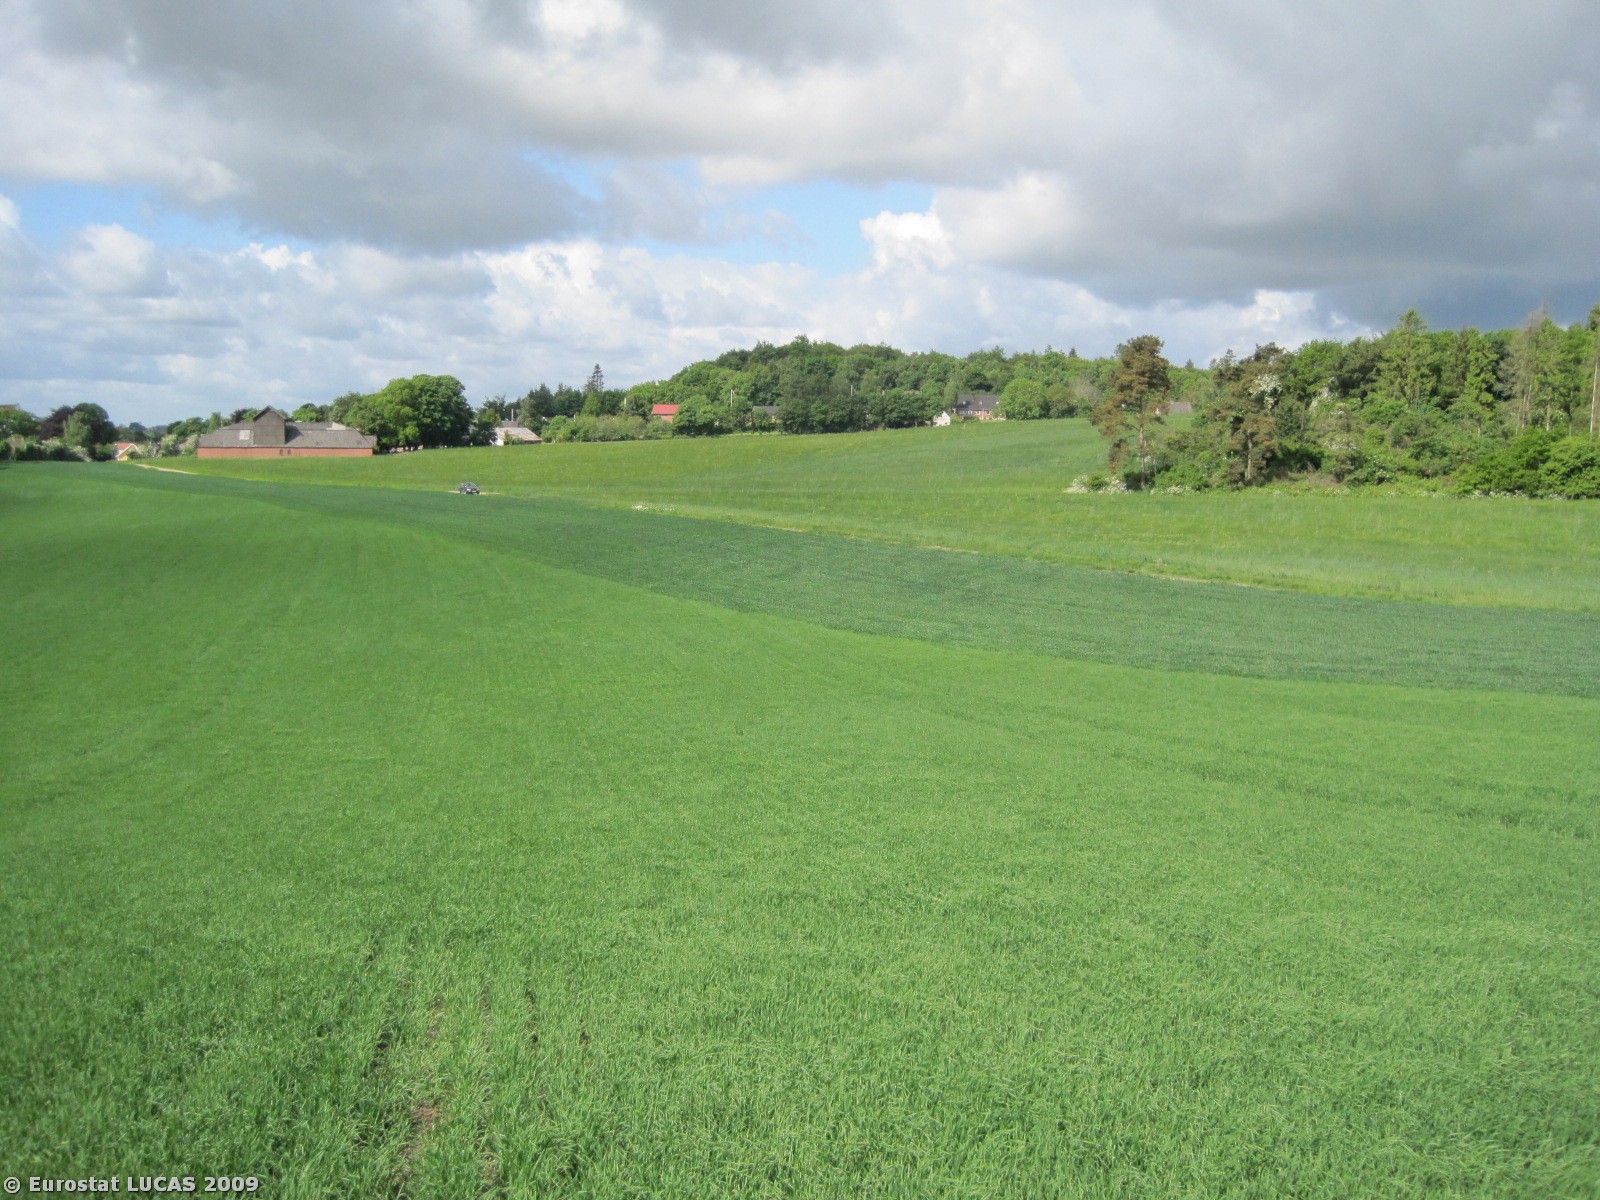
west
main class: Cropland
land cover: Barley
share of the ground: > 75 %
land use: Agriculture (excluding fallow land and kitchen gardens)
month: May
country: DK
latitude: 56.5649
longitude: 9.6912
